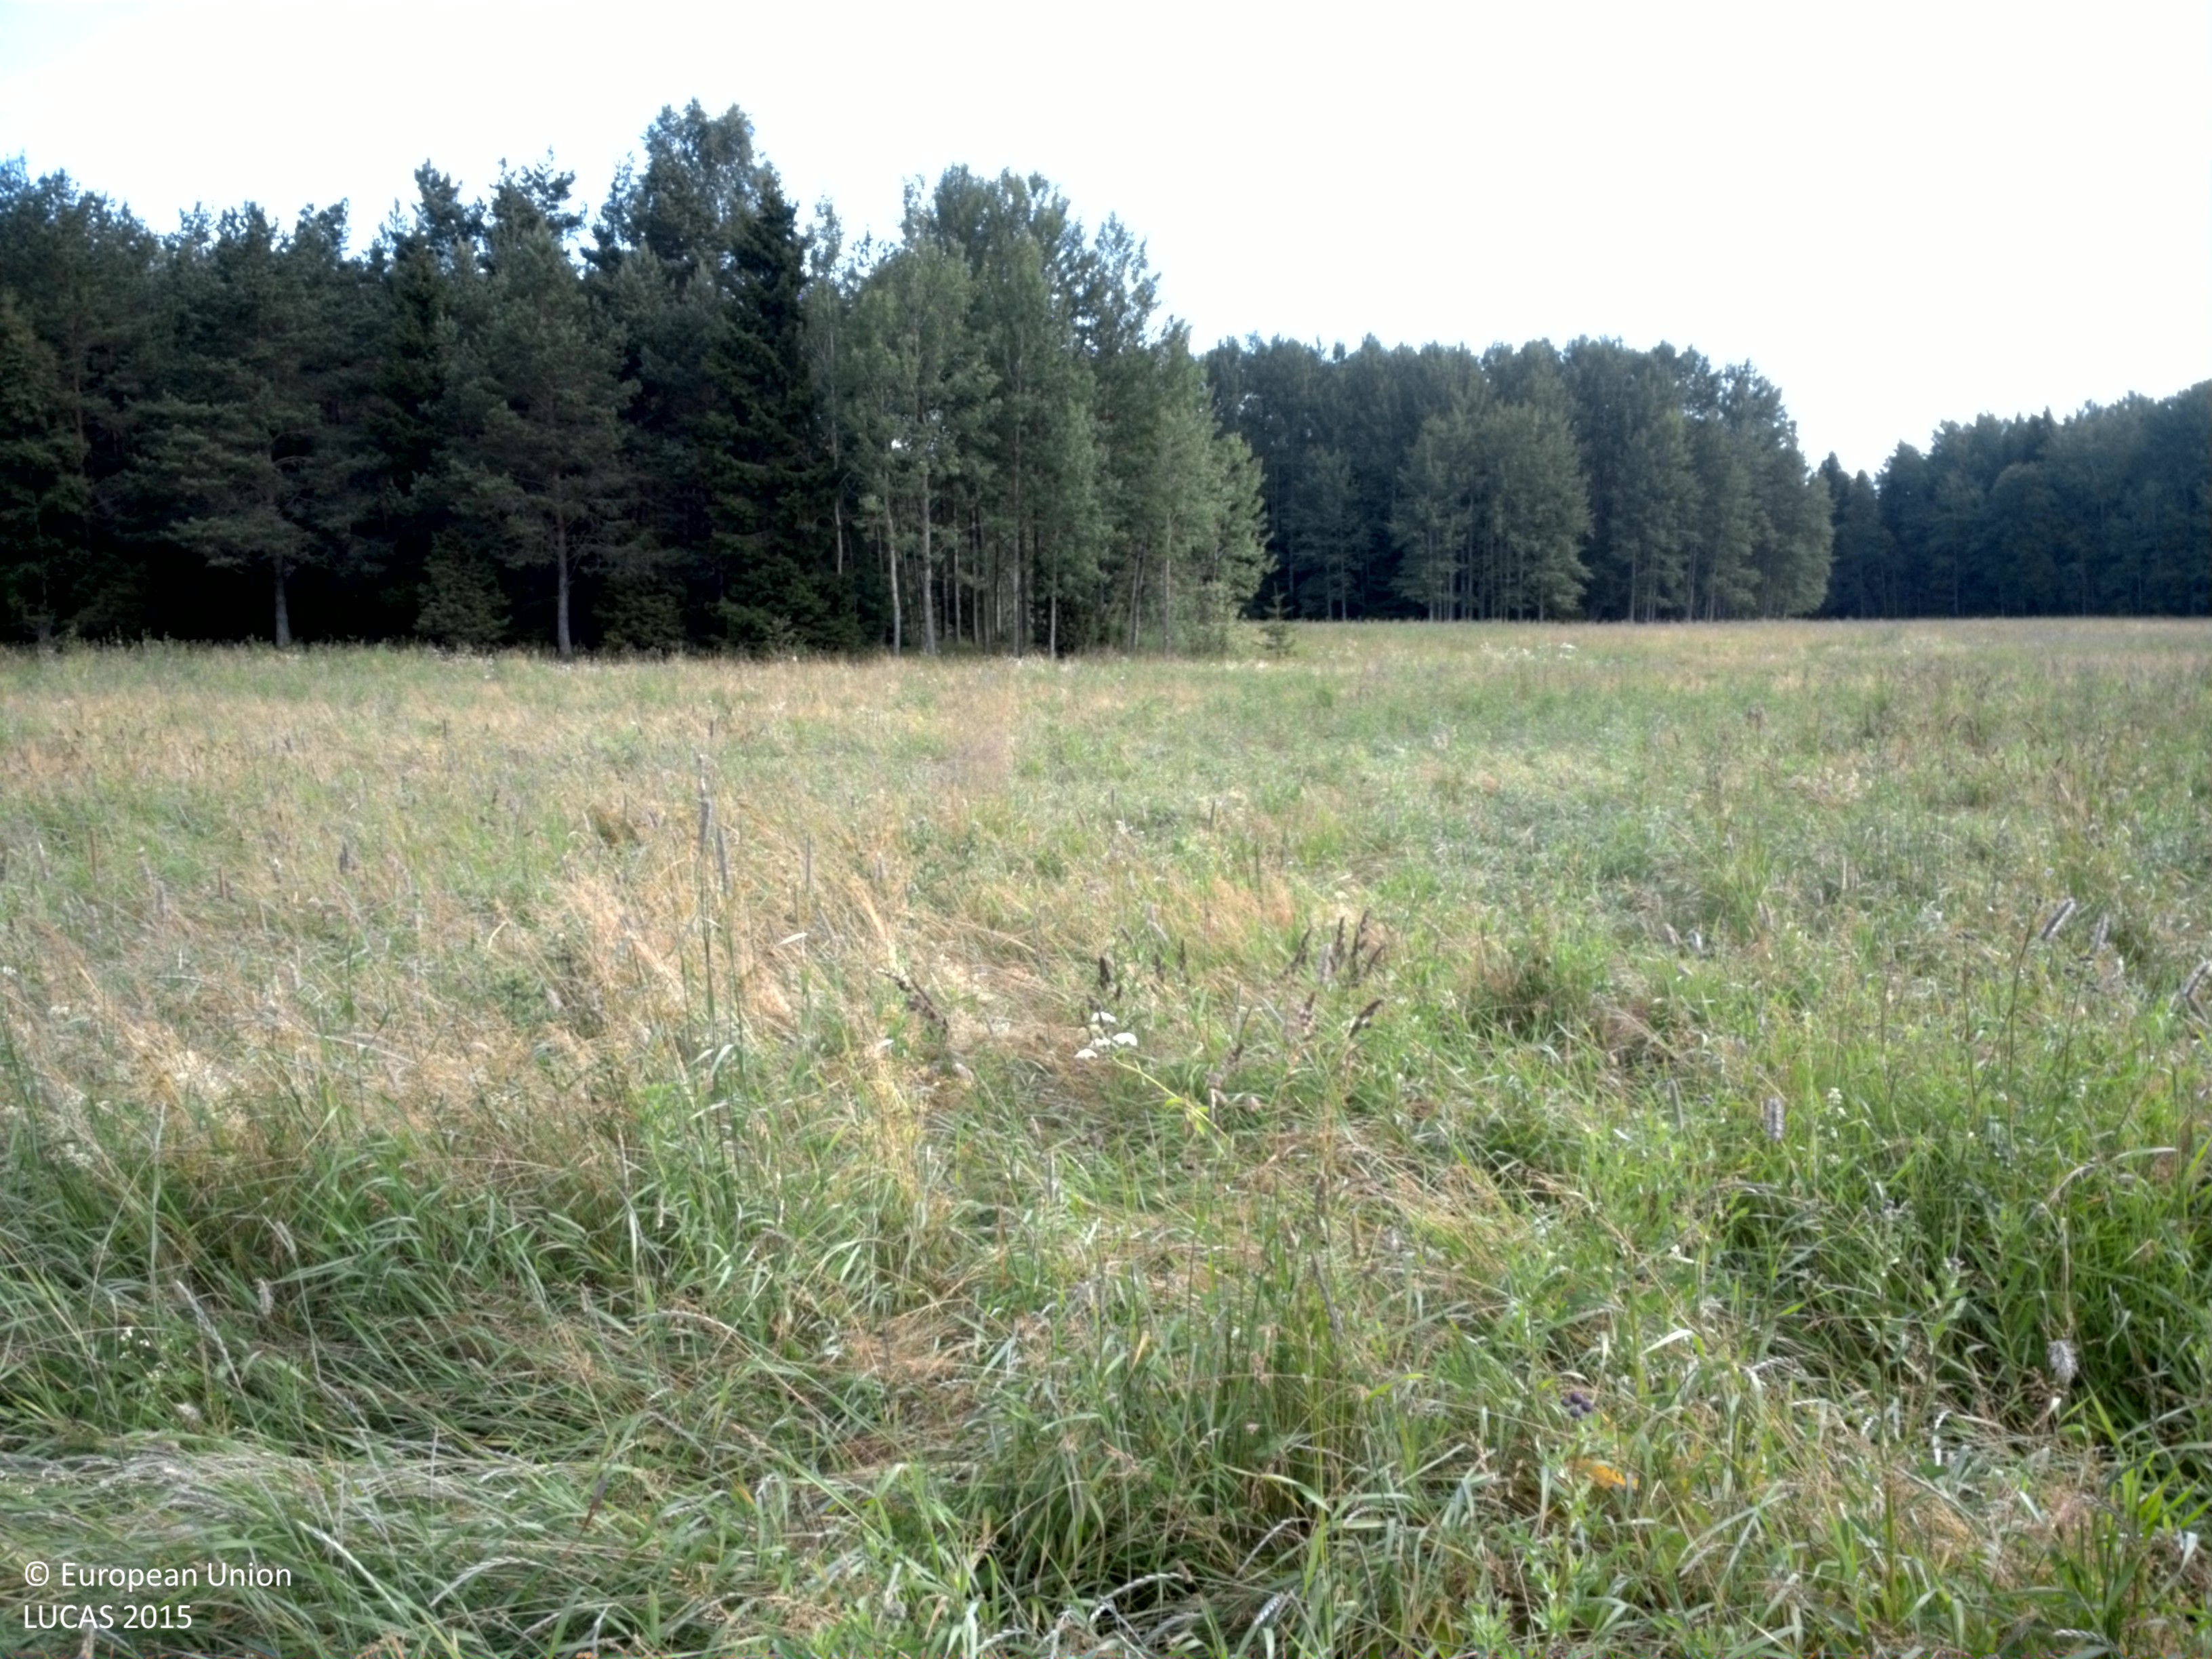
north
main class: Grassland
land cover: Grassland without tree/shrub cover
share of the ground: > 75 %
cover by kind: herbaceous plants 100 %
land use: Agriculture (excluding fallow land and kitchen gardens)
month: July
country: SE
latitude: 59.9624
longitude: 18.7572
